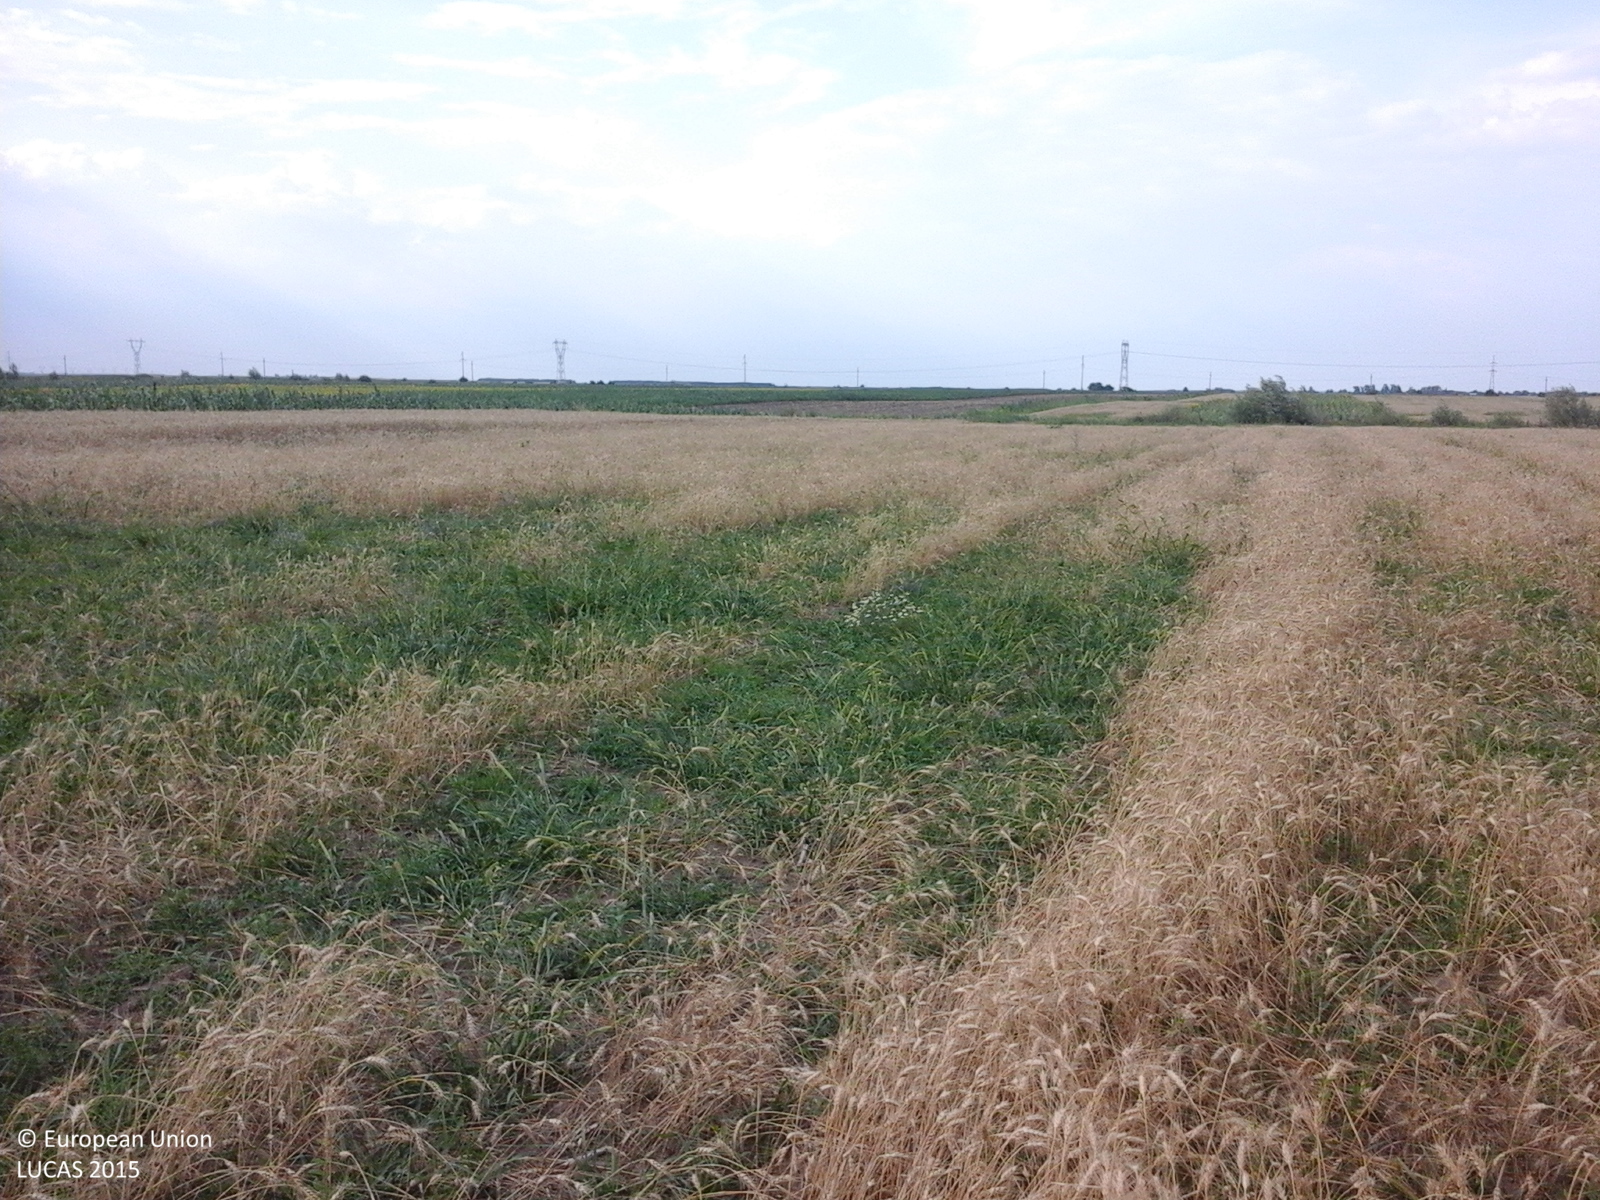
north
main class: Cropland
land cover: Common wheat
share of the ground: > 75 %
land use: Agriculture (excluding fallow land and kitchen gardens)
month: July
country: RO
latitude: 44.1358
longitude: 24.0718
